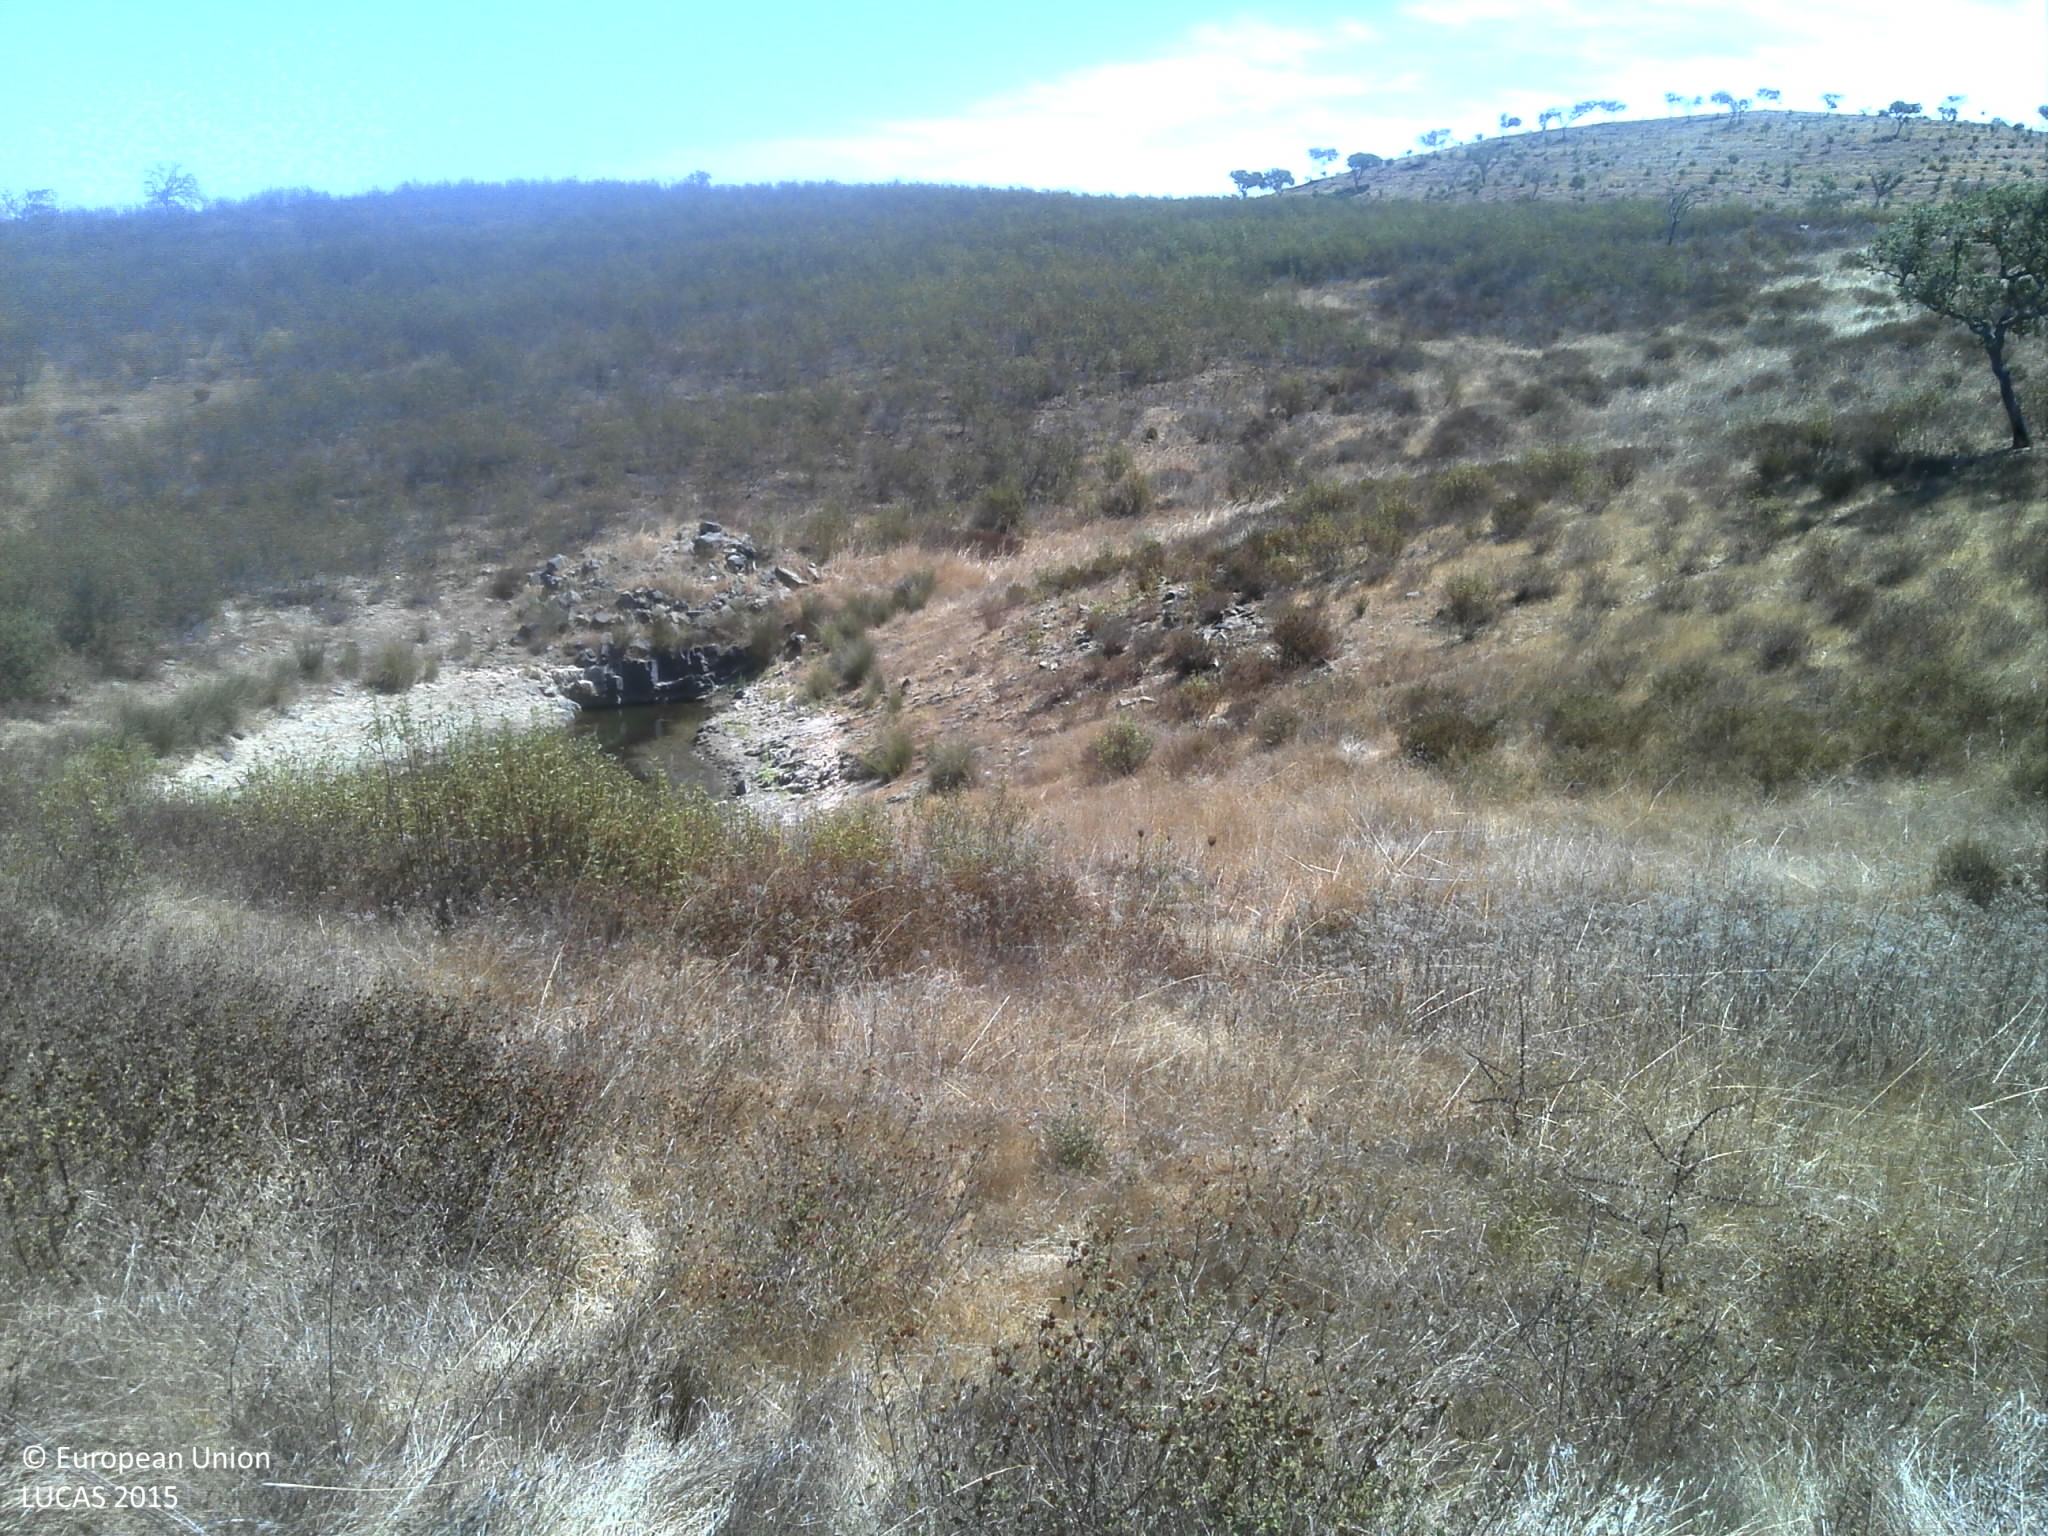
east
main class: Grassland
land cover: Grassland without tree/shrub cover
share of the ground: > 75 %
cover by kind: herbaceous plants 75 %, unconsolidated bare surface 25 %
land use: Agriculture (excluding fallow land and kitchen gardens)
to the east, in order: Grassland without tree/shrub cover; Shrubland without tree cover; Fences; Grass margins; Tracks; Grass margins; Fences; Shruby margins; Ditches and canals; Other structural elements; Broadleaved woodland; Other structural elements; Broadleaved woodland
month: August
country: PT
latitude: 37.5247
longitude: -8.2327
